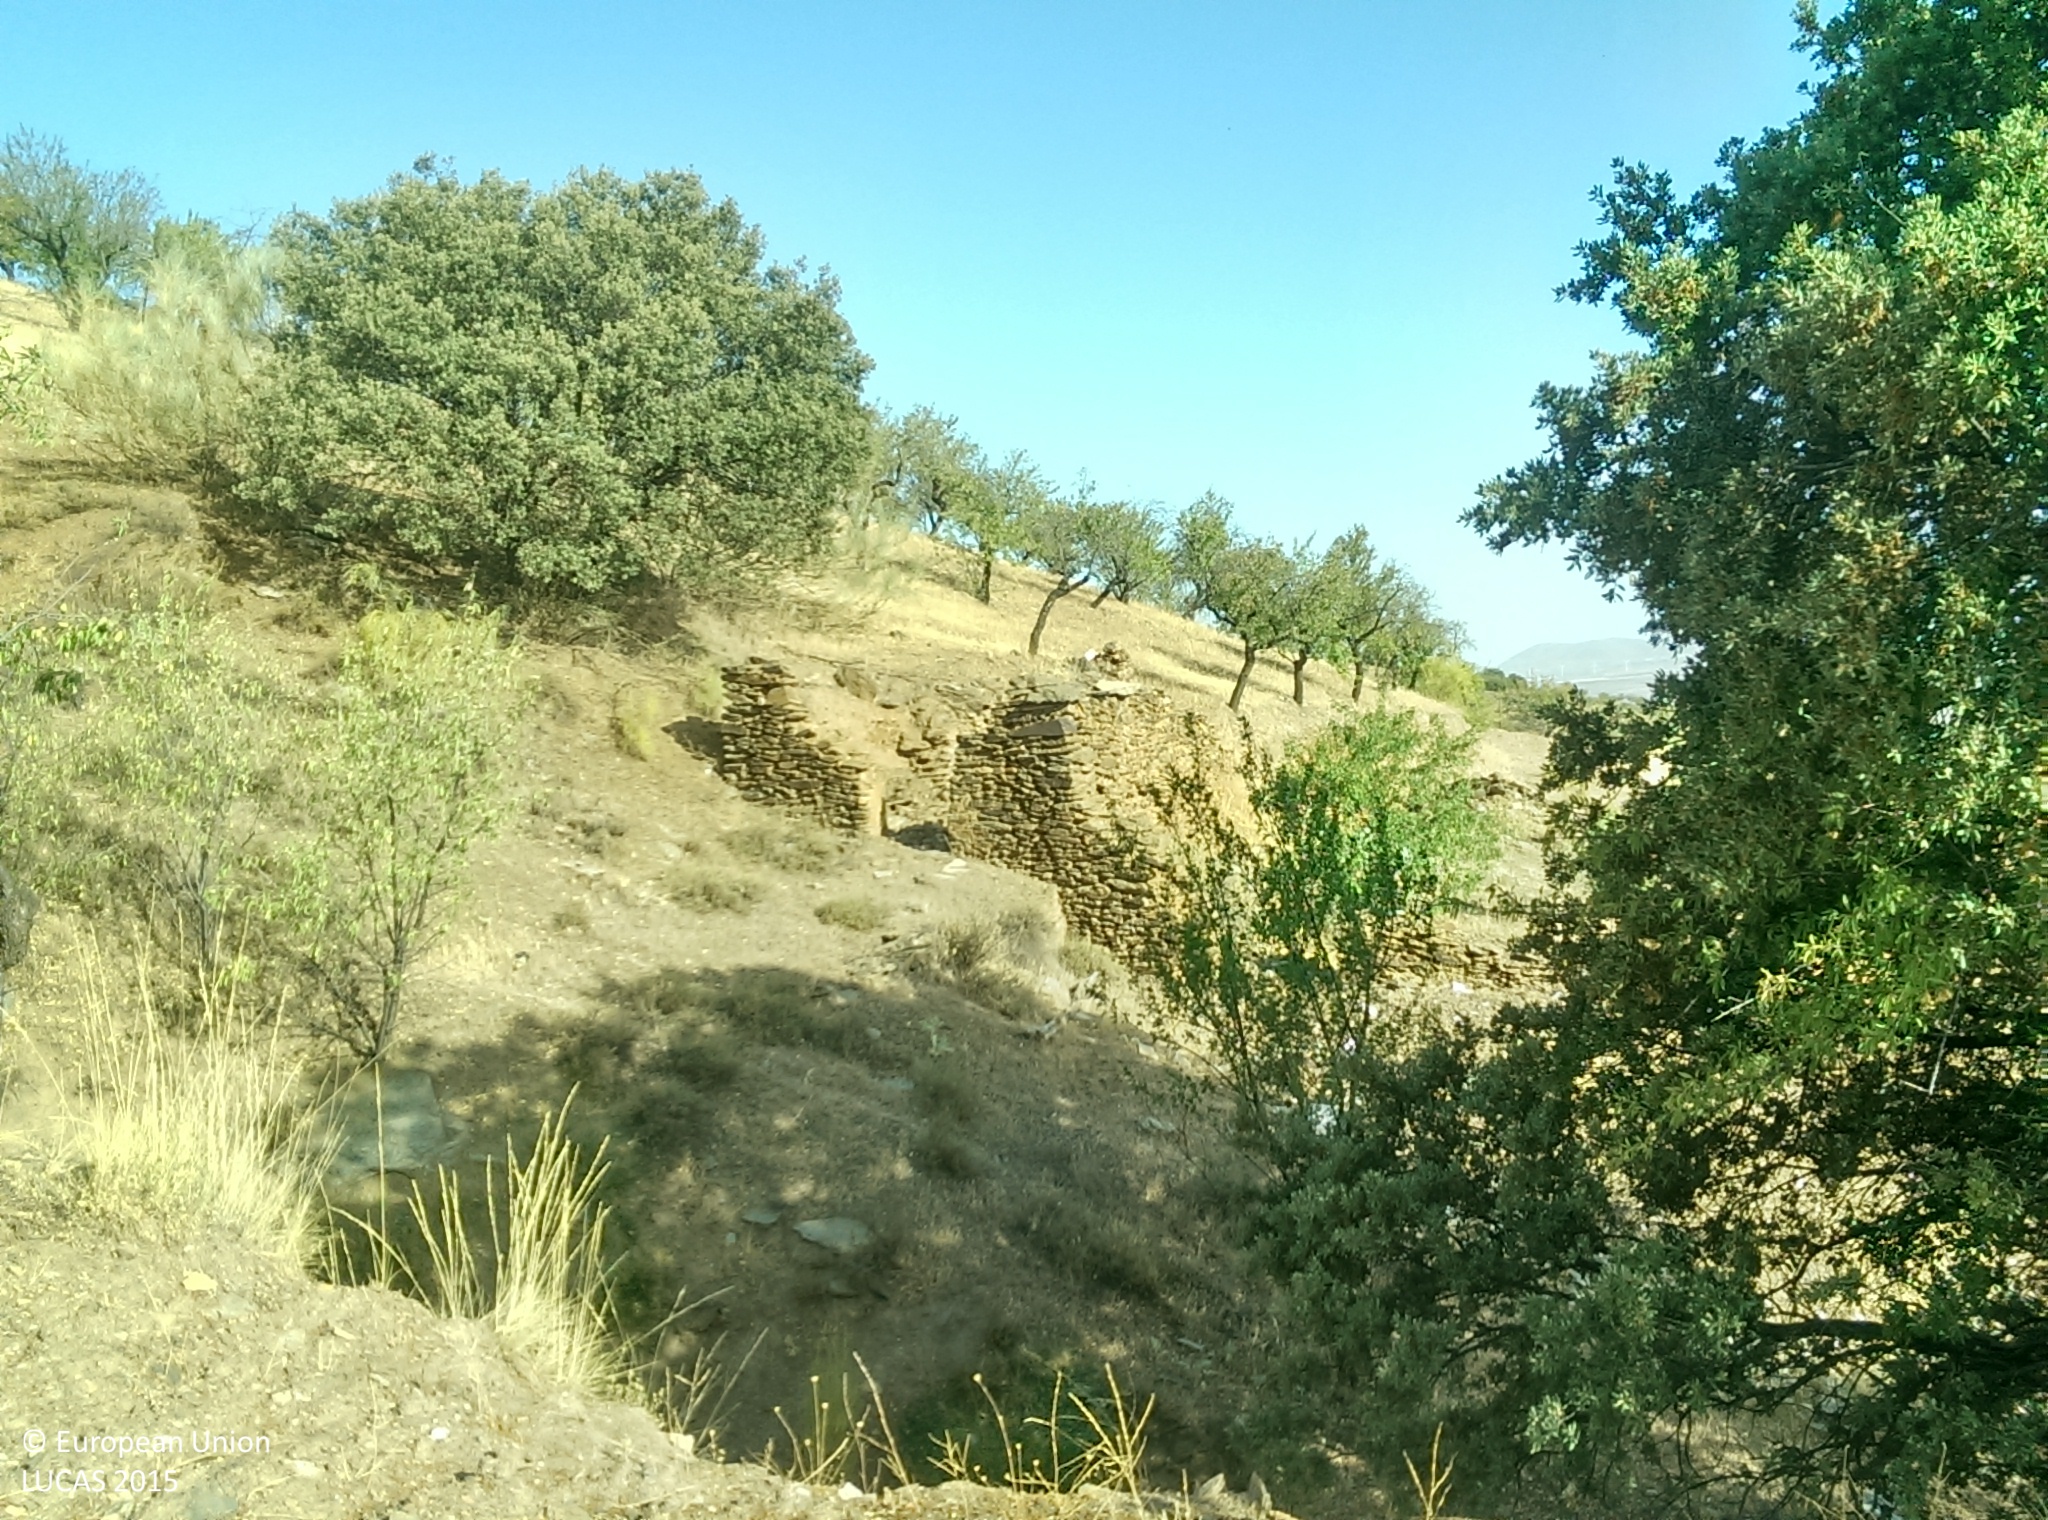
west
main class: Cropland
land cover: Nuts trees
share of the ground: < 10 %
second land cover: Other bare soil
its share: > 75 %
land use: Agriculture (excluding fallow land and kitchen gardens)
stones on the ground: 25 - 50 %
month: July
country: ES
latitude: 37.1319
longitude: -2.8257
